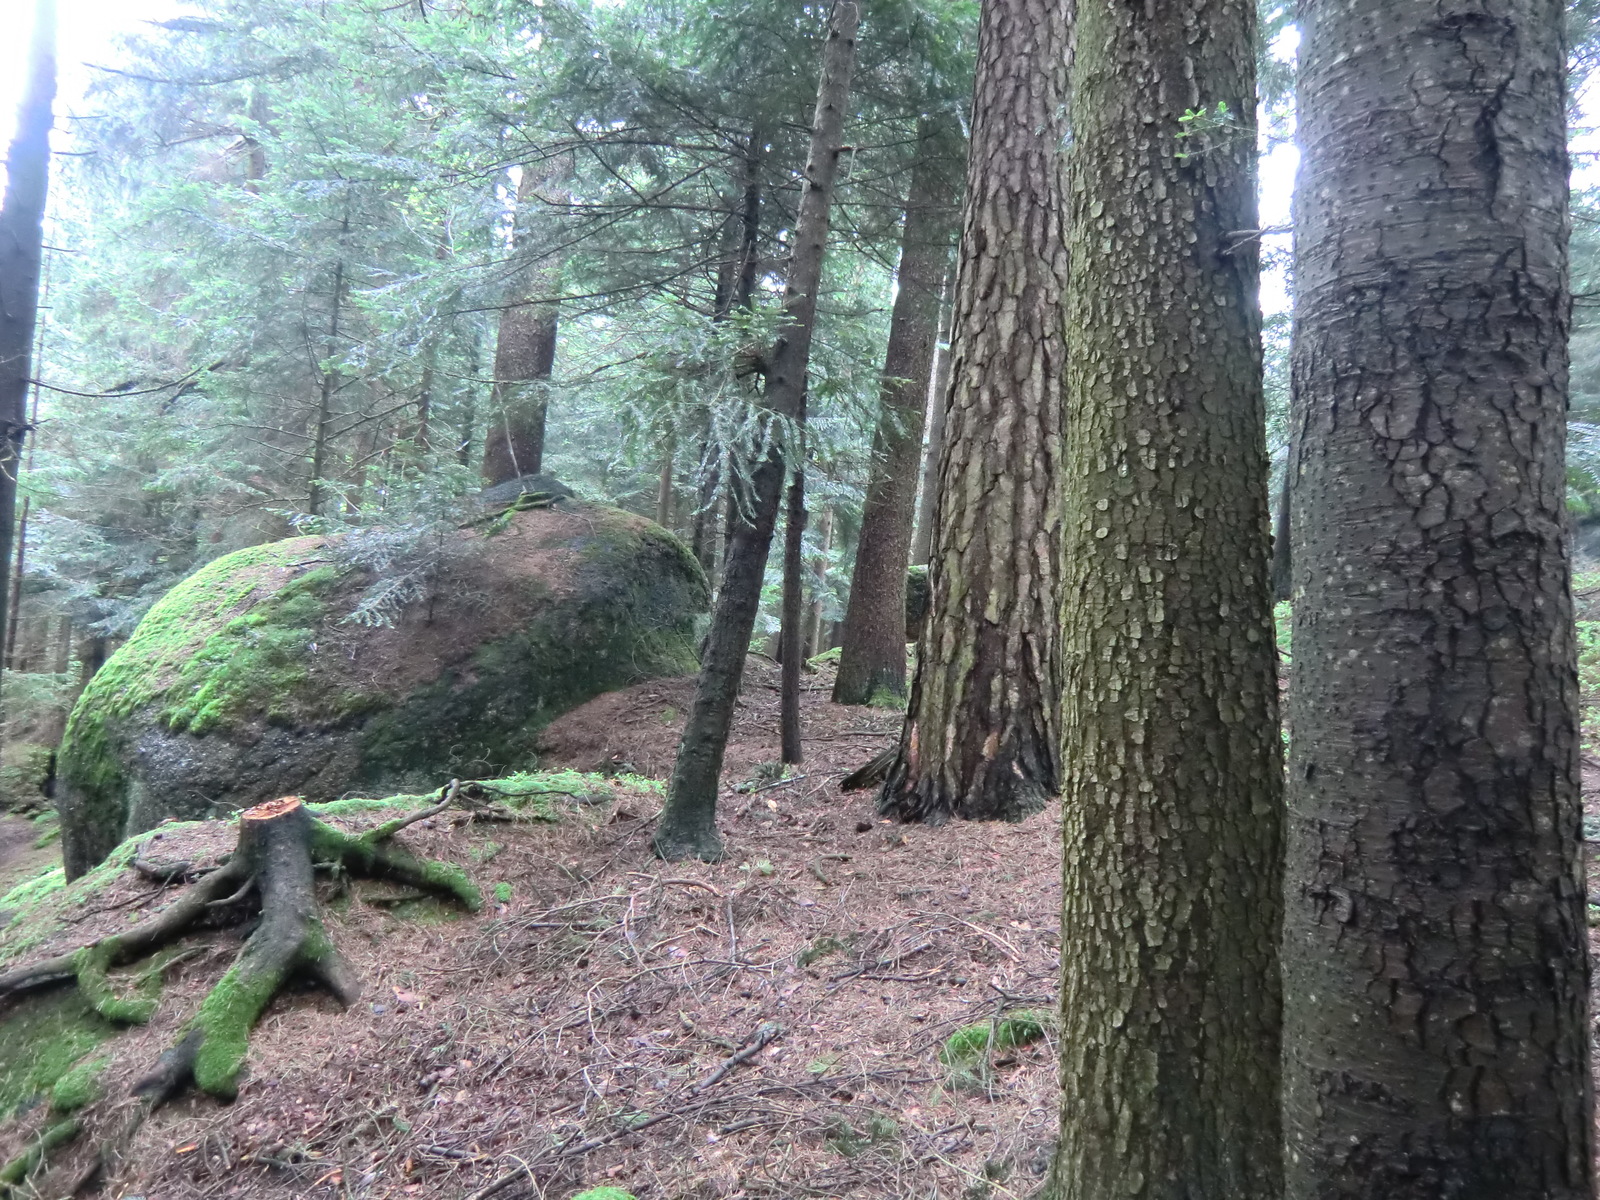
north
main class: Woodland
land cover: Spruce dominated coniferous woodland
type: hemiboreal forest and nemoral coniferous forest and mixed broadleaved-coniferous forest
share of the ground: > 75 %
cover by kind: coniferous forest trees 80 %, unconsolidated bare surface 10 %, lichens and mosses 5 %
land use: Forestry
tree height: > 5 m
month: May
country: AT
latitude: 48.3190
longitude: 14.7614
